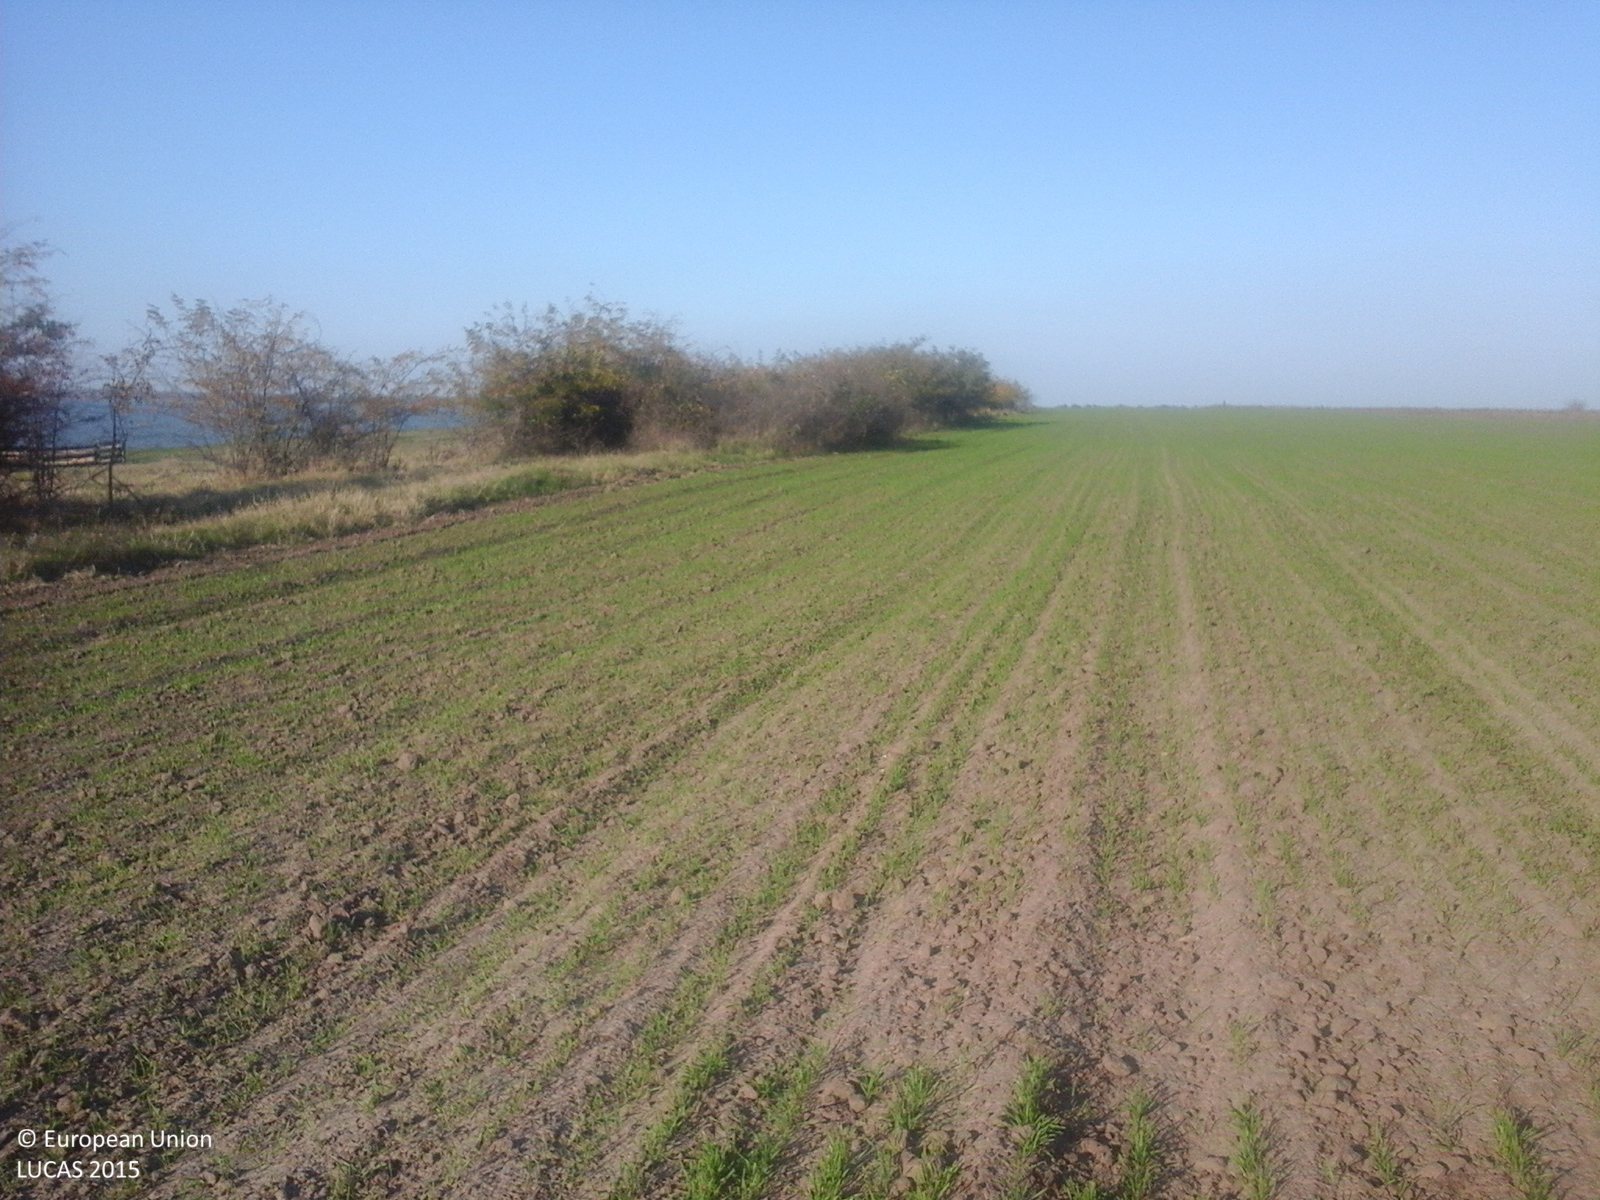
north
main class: Cropland
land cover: Common wheat
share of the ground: 10 - 25 %
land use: Agriculture (excluding fallow land and kitchen gardens)
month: October
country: RO
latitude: 45.2706
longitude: 27.3409
